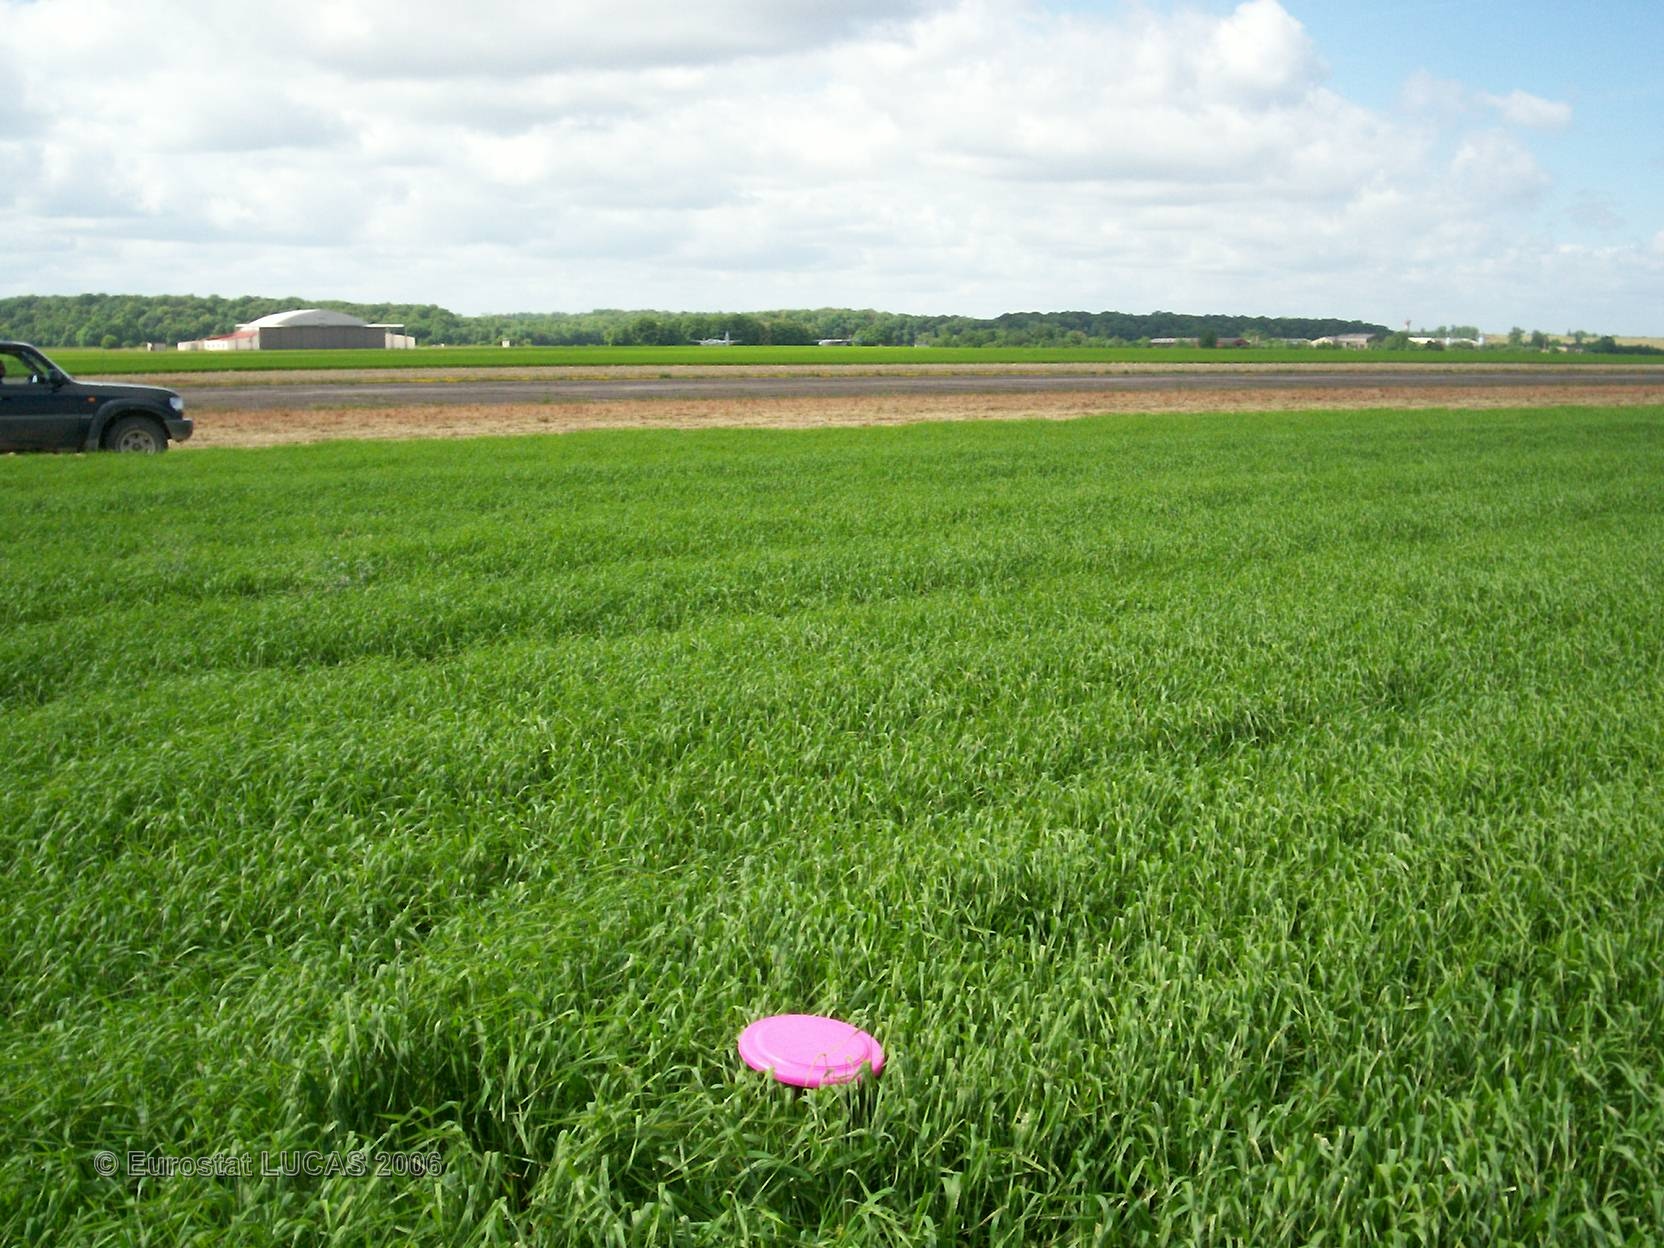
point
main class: Cropland
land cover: Barley
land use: Agriculture (excluding fallow land and kitchen gardens)
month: May
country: FR
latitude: 48.4288
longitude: 4.4968
